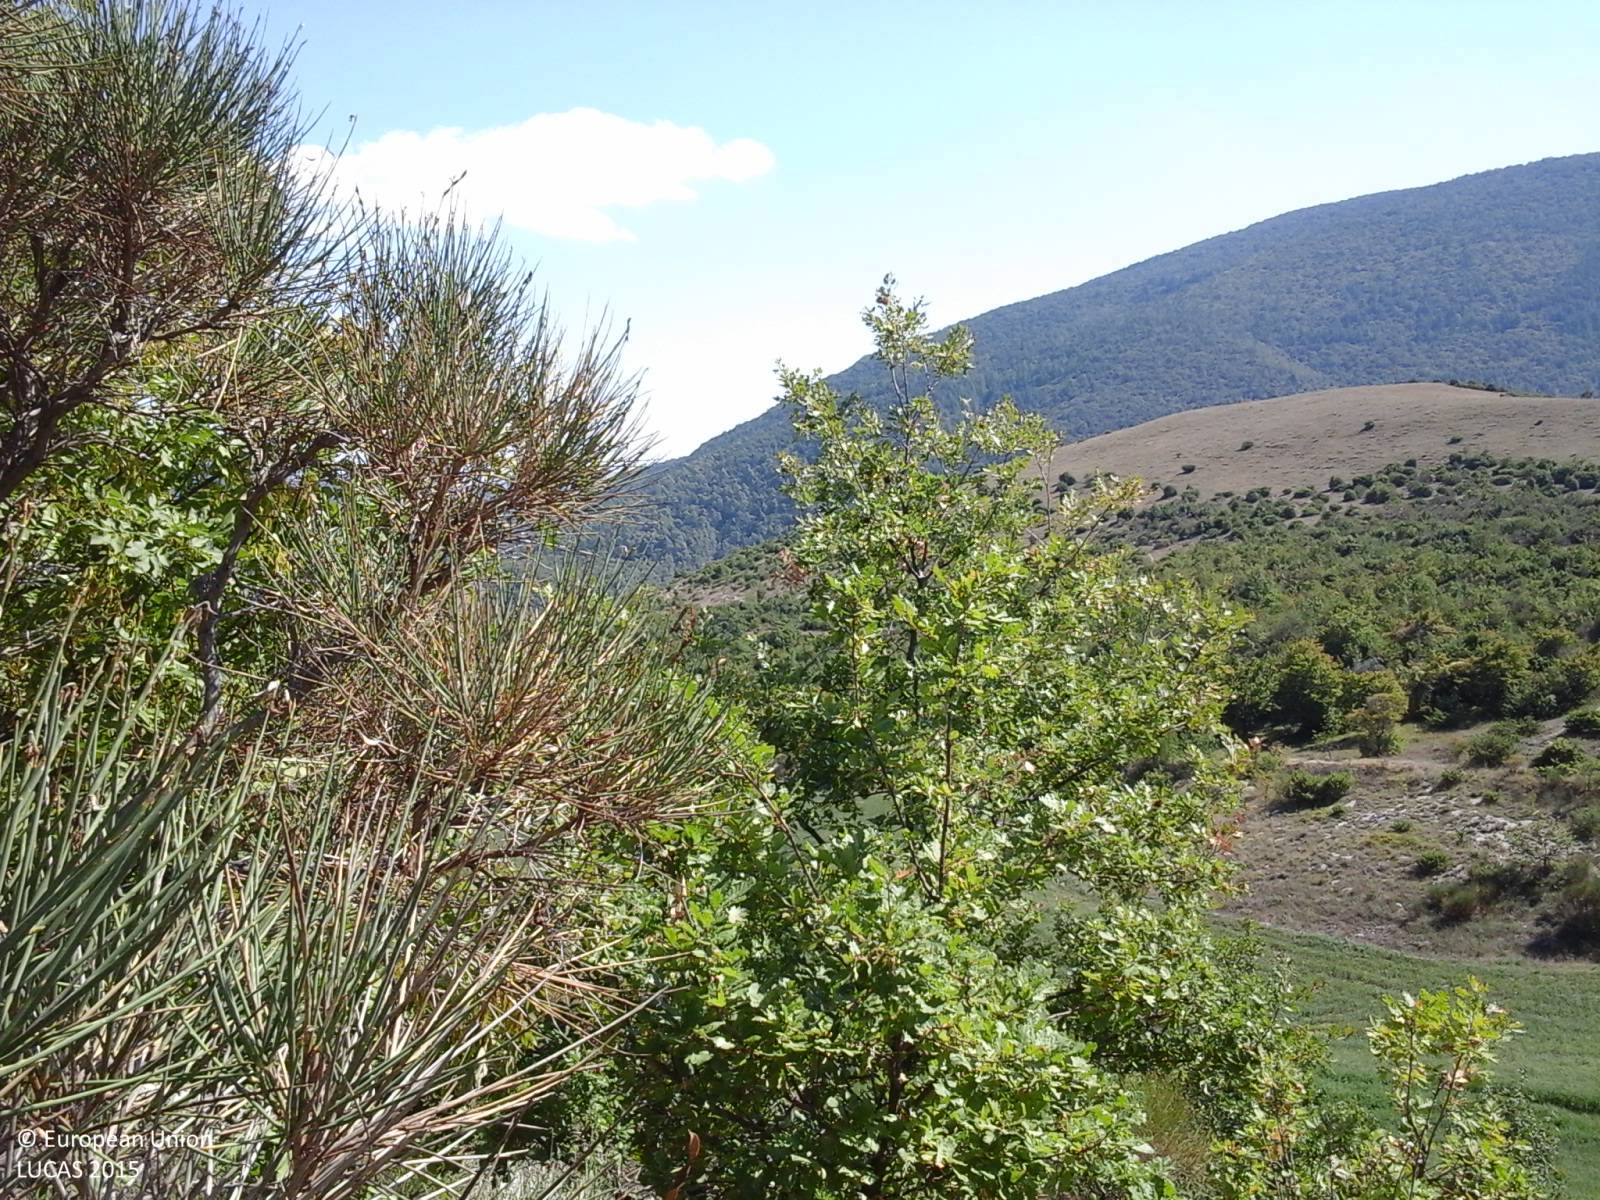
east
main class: Shrubland
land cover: Shrubland with sparse tree cover
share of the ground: > 75 %
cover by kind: shrubs 75 %, herbaceous plants 20 %, broadleaved forest trees 5 %
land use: Semi-natural and natural areas not in use
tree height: < 5 m
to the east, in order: Shrubland with sparse tree cover; Tracks; Shrubland with sparse tree cover; Broadleaved woodland; Tracks; Lucerne; Ditches and canals; Lucerne; Ditches and canals; Lucerne
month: September
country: IT
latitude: 43.0895
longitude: 12.6336
